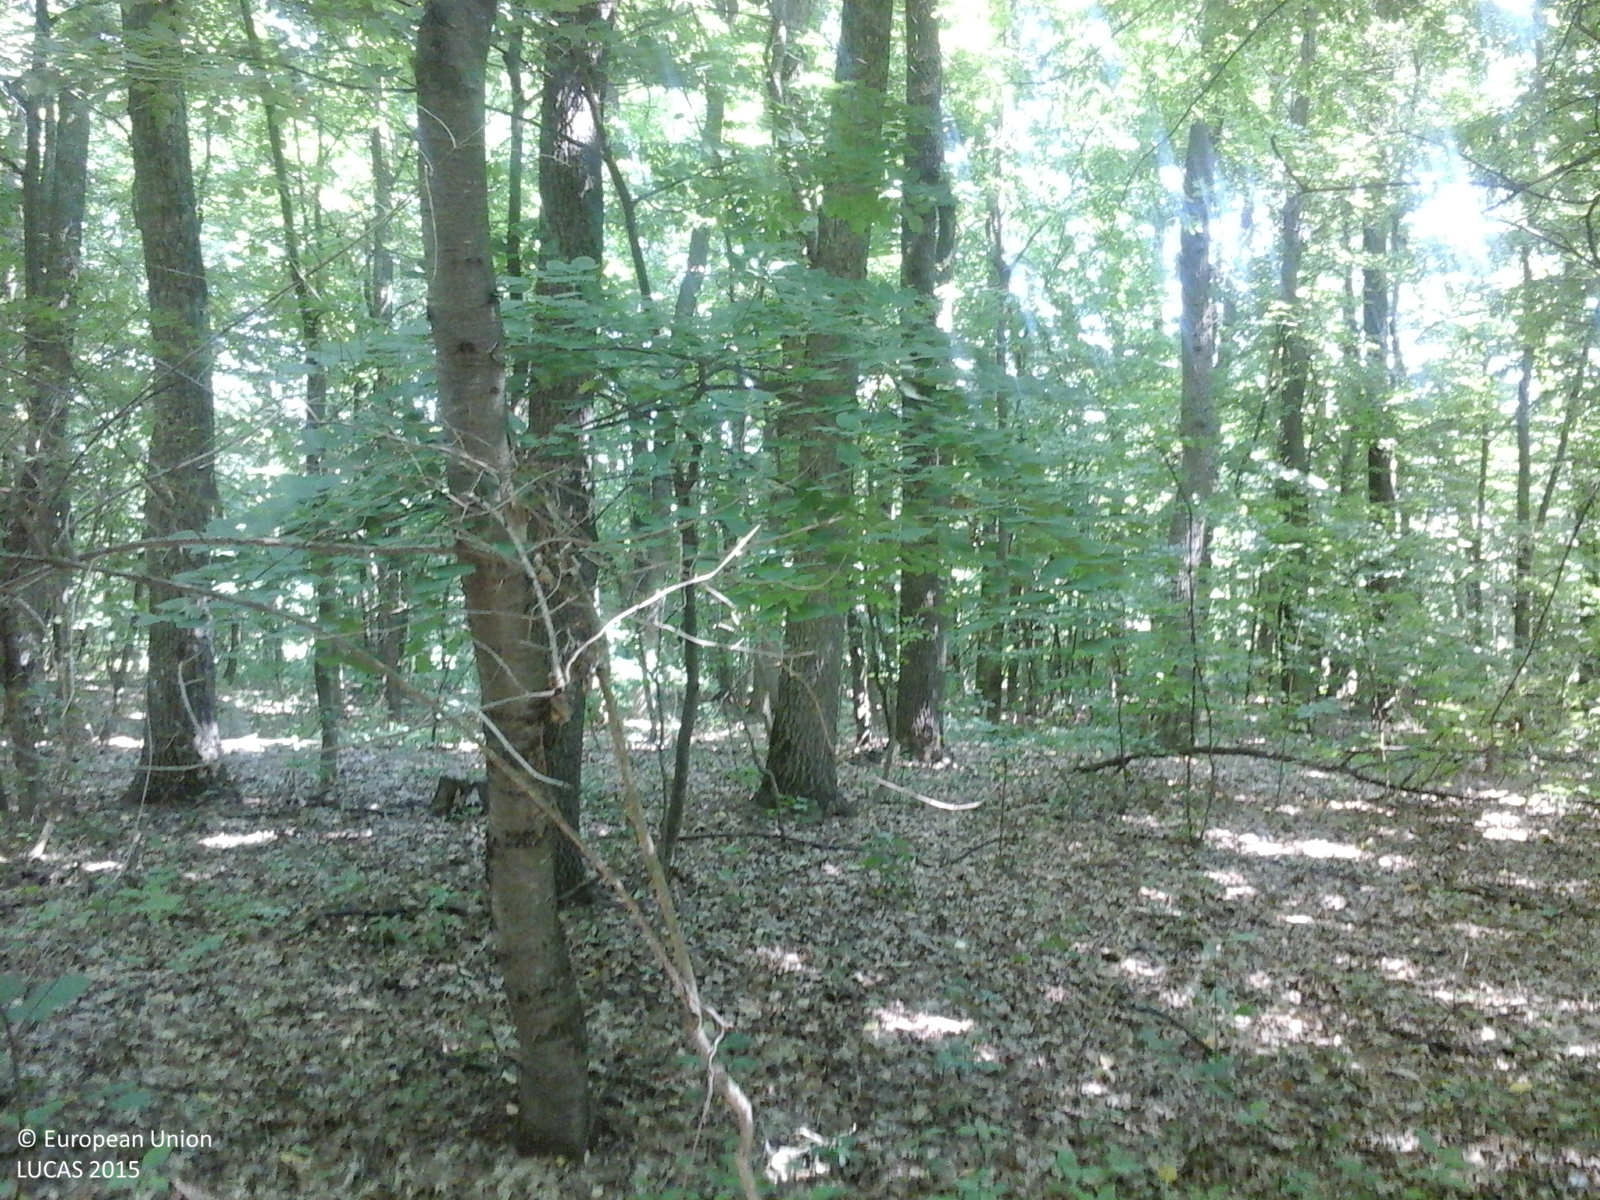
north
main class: Woodland
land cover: Broadleaved woodland
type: beech forest
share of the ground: > 75 %
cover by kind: broadleaved forest trees 100 %
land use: Forestry
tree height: > 5 m
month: June
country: RO
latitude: 46.6983
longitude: 27.2767
